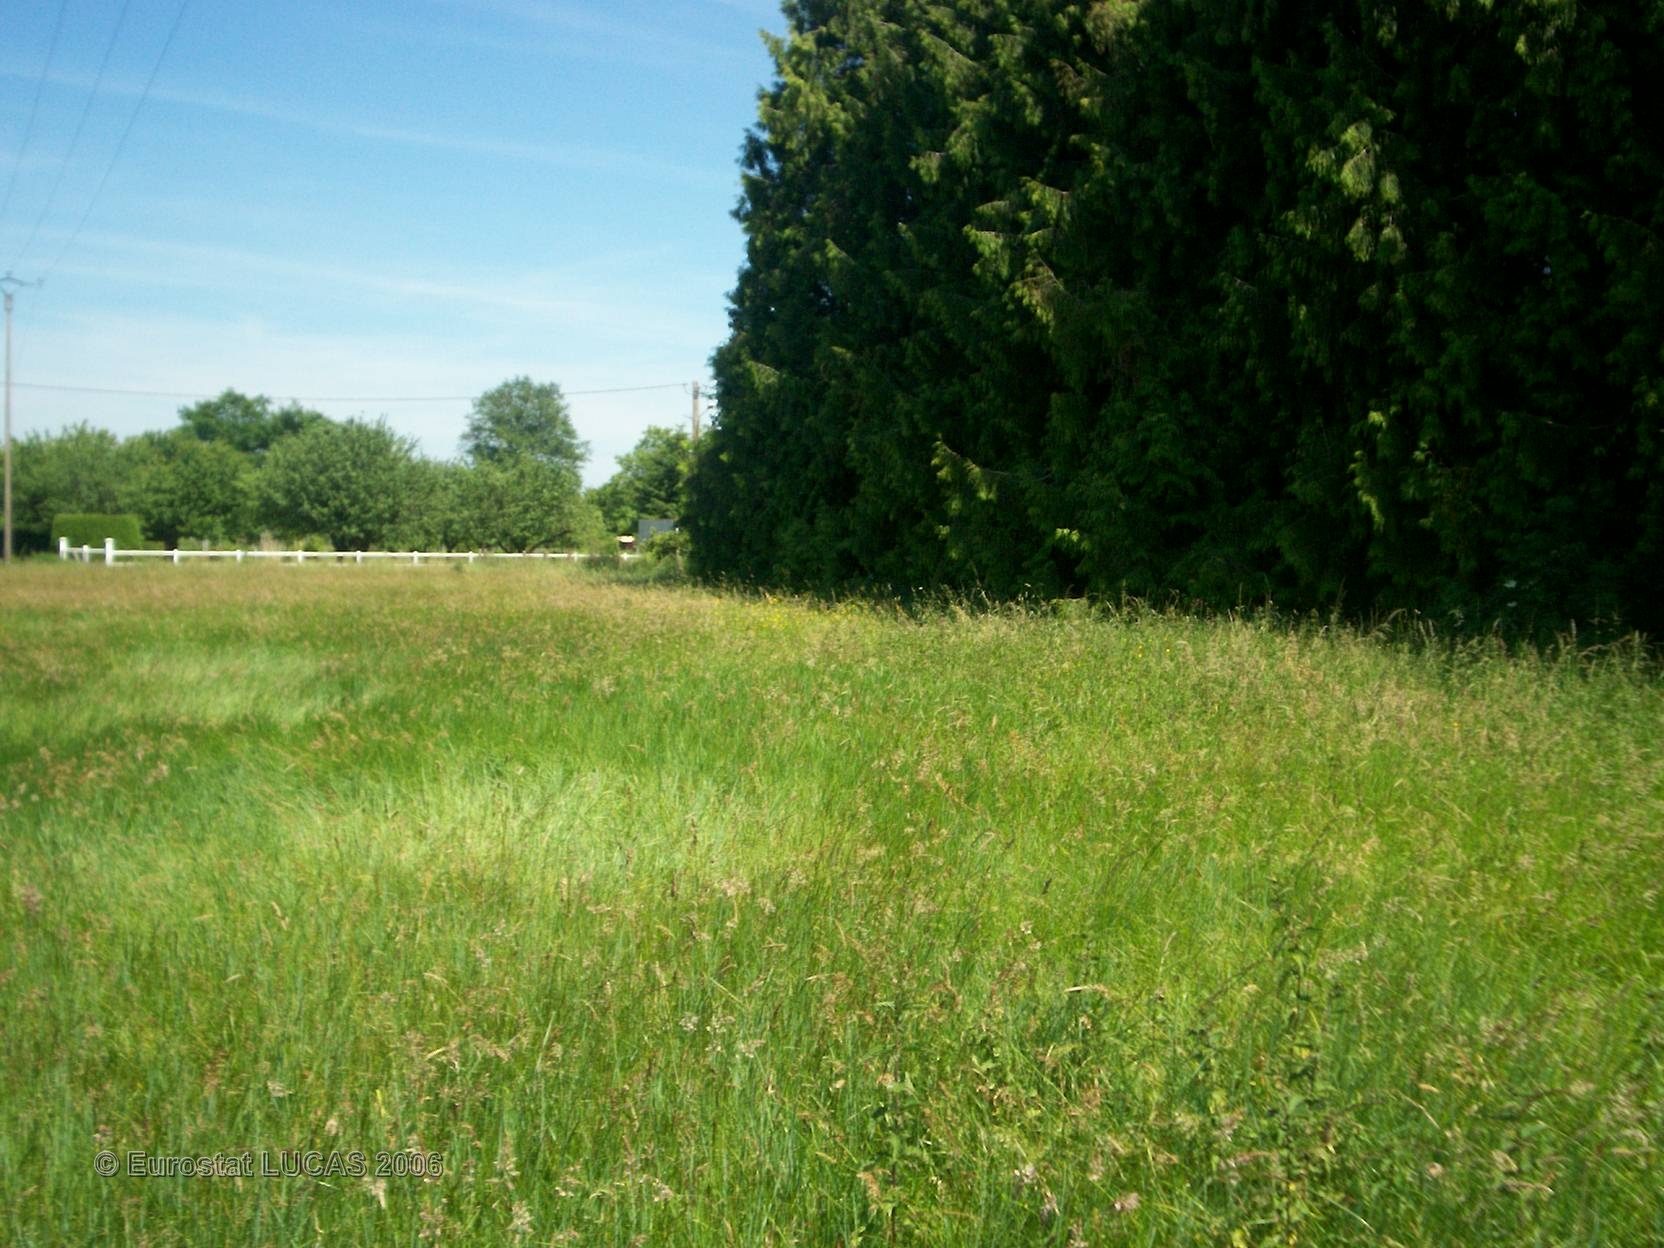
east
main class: Grassland
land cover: Grassland without tree/shrub cover
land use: Agriculture (excluding fallow land and kitchen gardens)
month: June
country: FR
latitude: 46.9577
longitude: 3.0709
